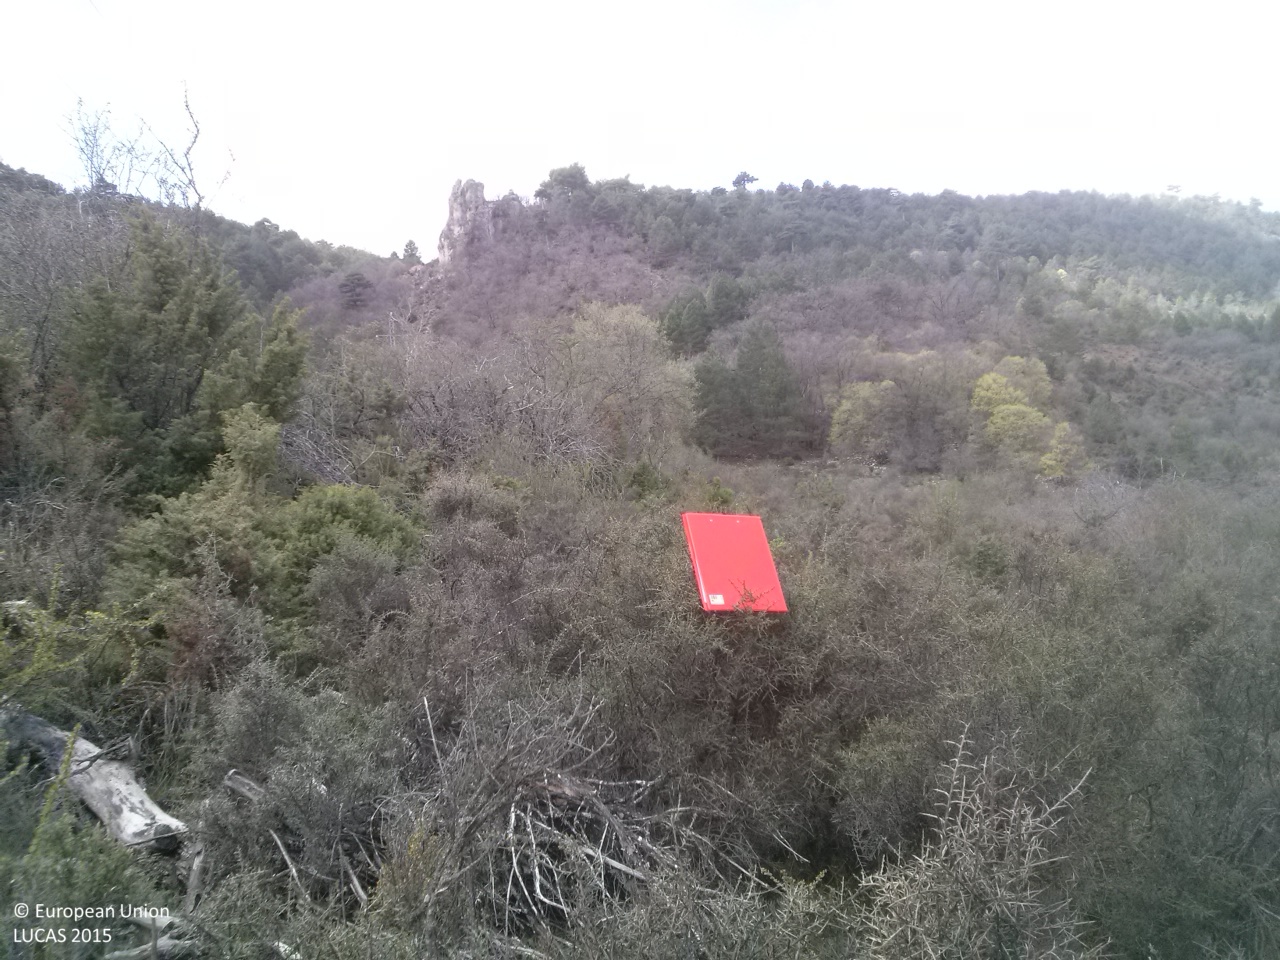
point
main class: Artificial land
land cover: Other artificial areas
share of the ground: < 10 %
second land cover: Shrubland with sparse tree cover
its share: > 75 %
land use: Electricity, gas and thermal power distribution
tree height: > 5 m
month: April
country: ES
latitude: 40.2788
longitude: -1.8356
